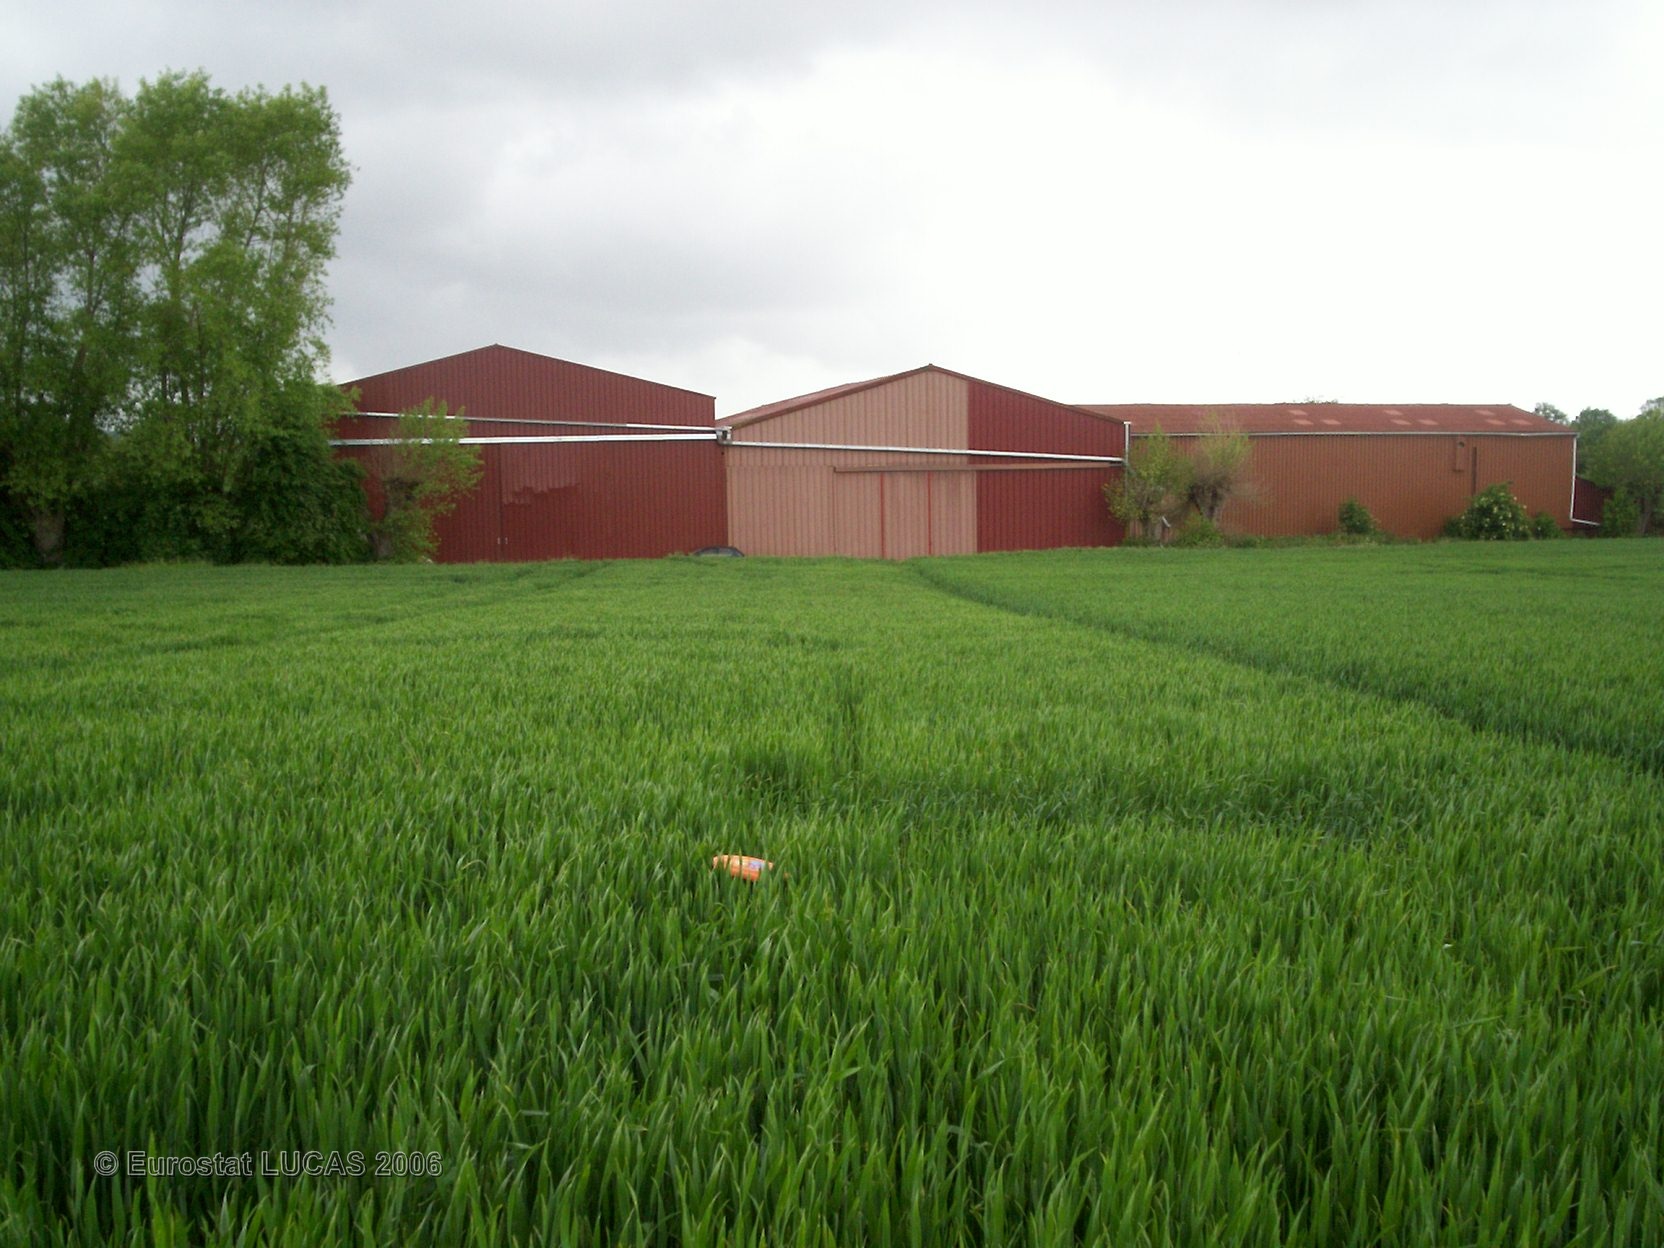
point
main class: Cropland
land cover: Common wheat
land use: Agriculture (excluding fallow land and kitchen gardens)
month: May
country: FR
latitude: 50.4452
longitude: 2.5382
